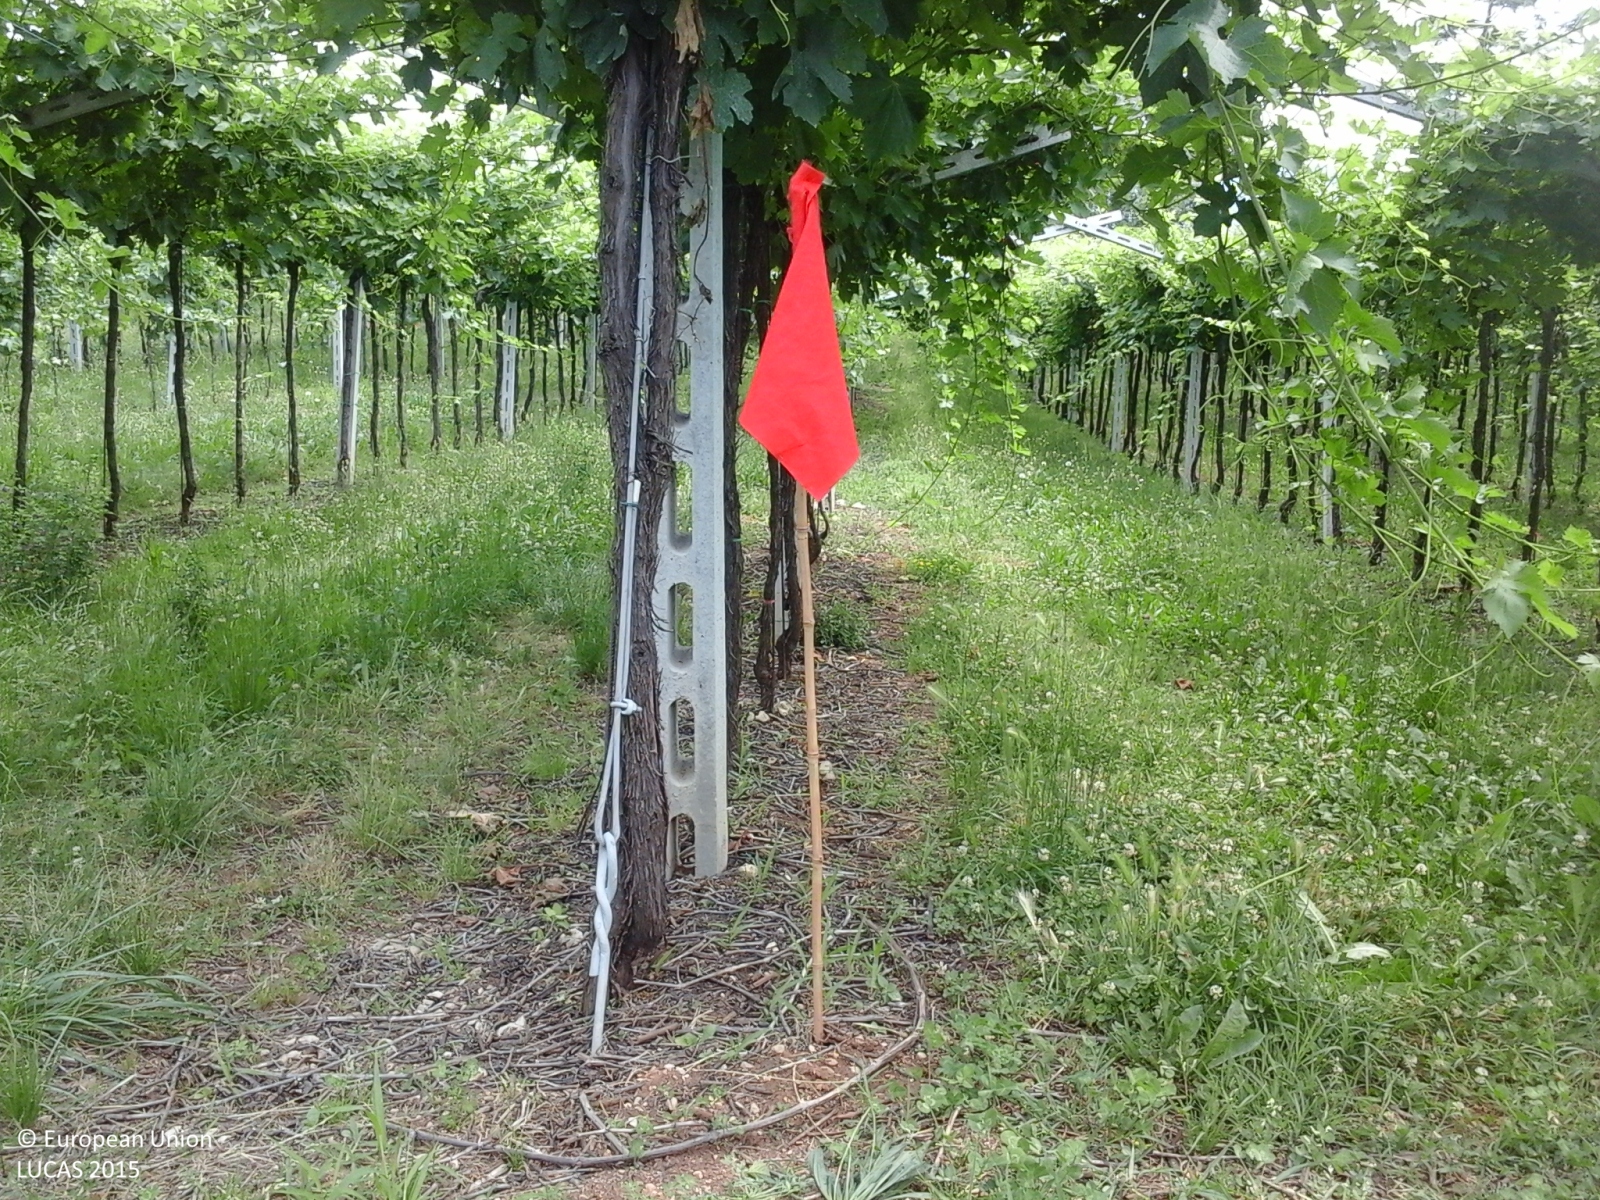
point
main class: Cropland
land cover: Vineyards
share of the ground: > 75 %
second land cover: Grassland without tree/shrub cover
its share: > 75 %
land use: Agriculture (excluding fallow land and kitchen gardens)
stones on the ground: < 10 %
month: June
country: IT
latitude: 45.5546
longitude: 10.9080
